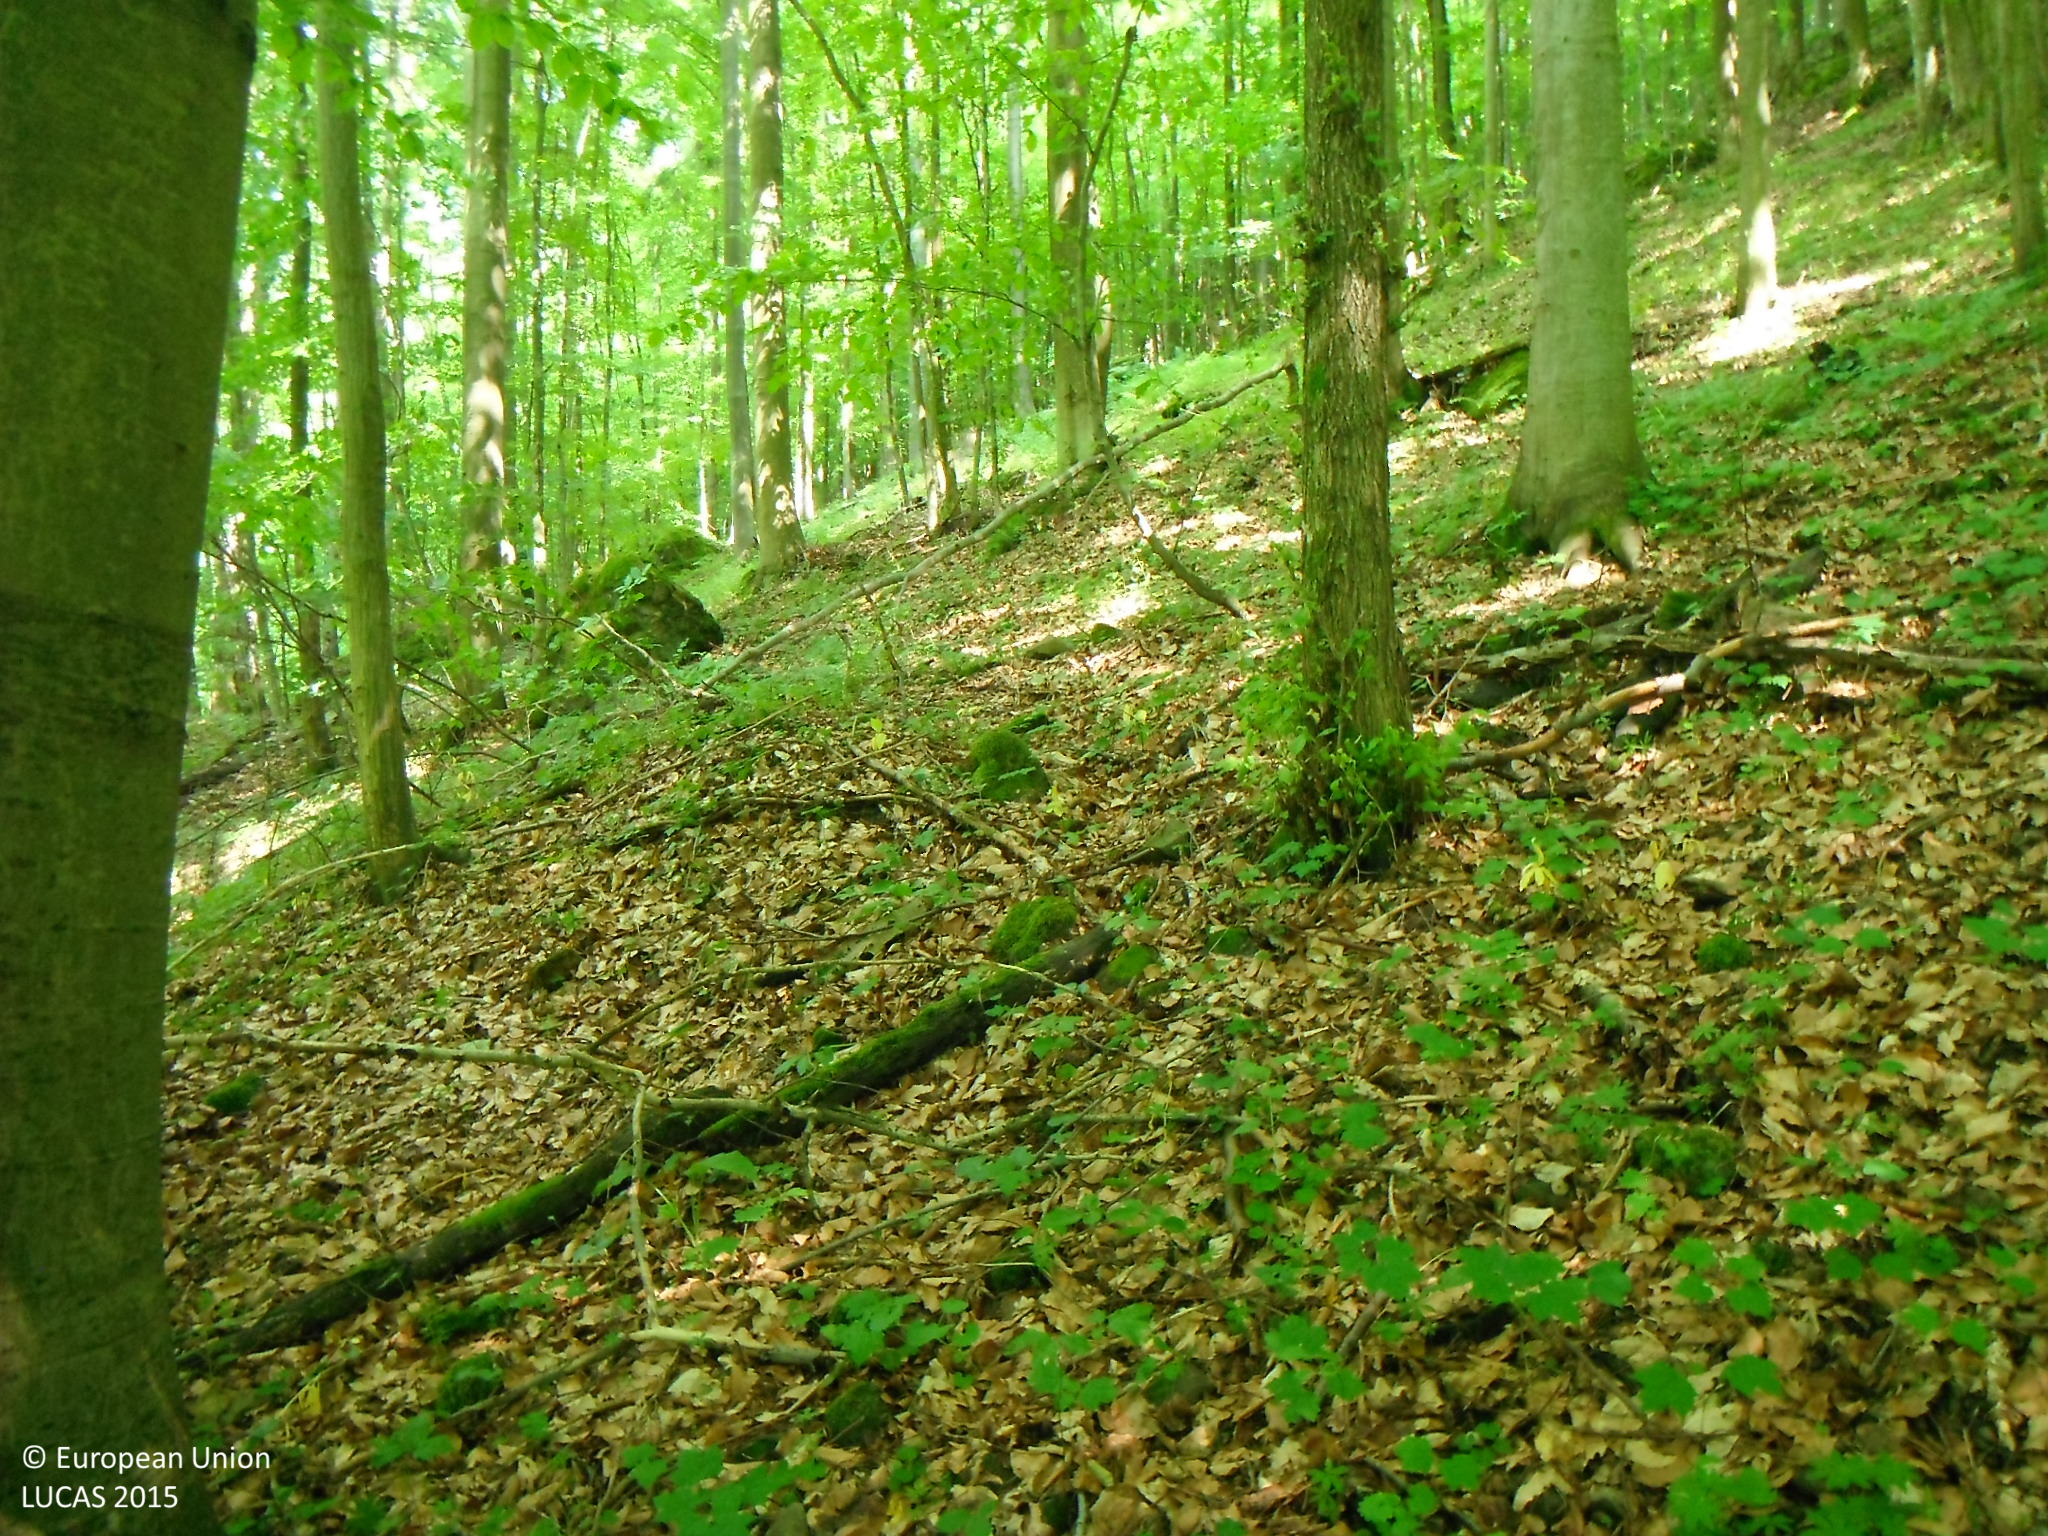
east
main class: Woodland
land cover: Other mixed woodland
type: hemiboreal forest and nemoral coniferous forest and mixed broadleaved-coniferous forest
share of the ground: > 75 %
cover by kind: coniferous forest trees 50 %, broadleaved forest trees 50 %
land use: Forestry
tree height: > 5 m
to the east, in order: Other mixed woodland
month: June
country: SK
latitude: 48.6875
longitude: 19.0000
